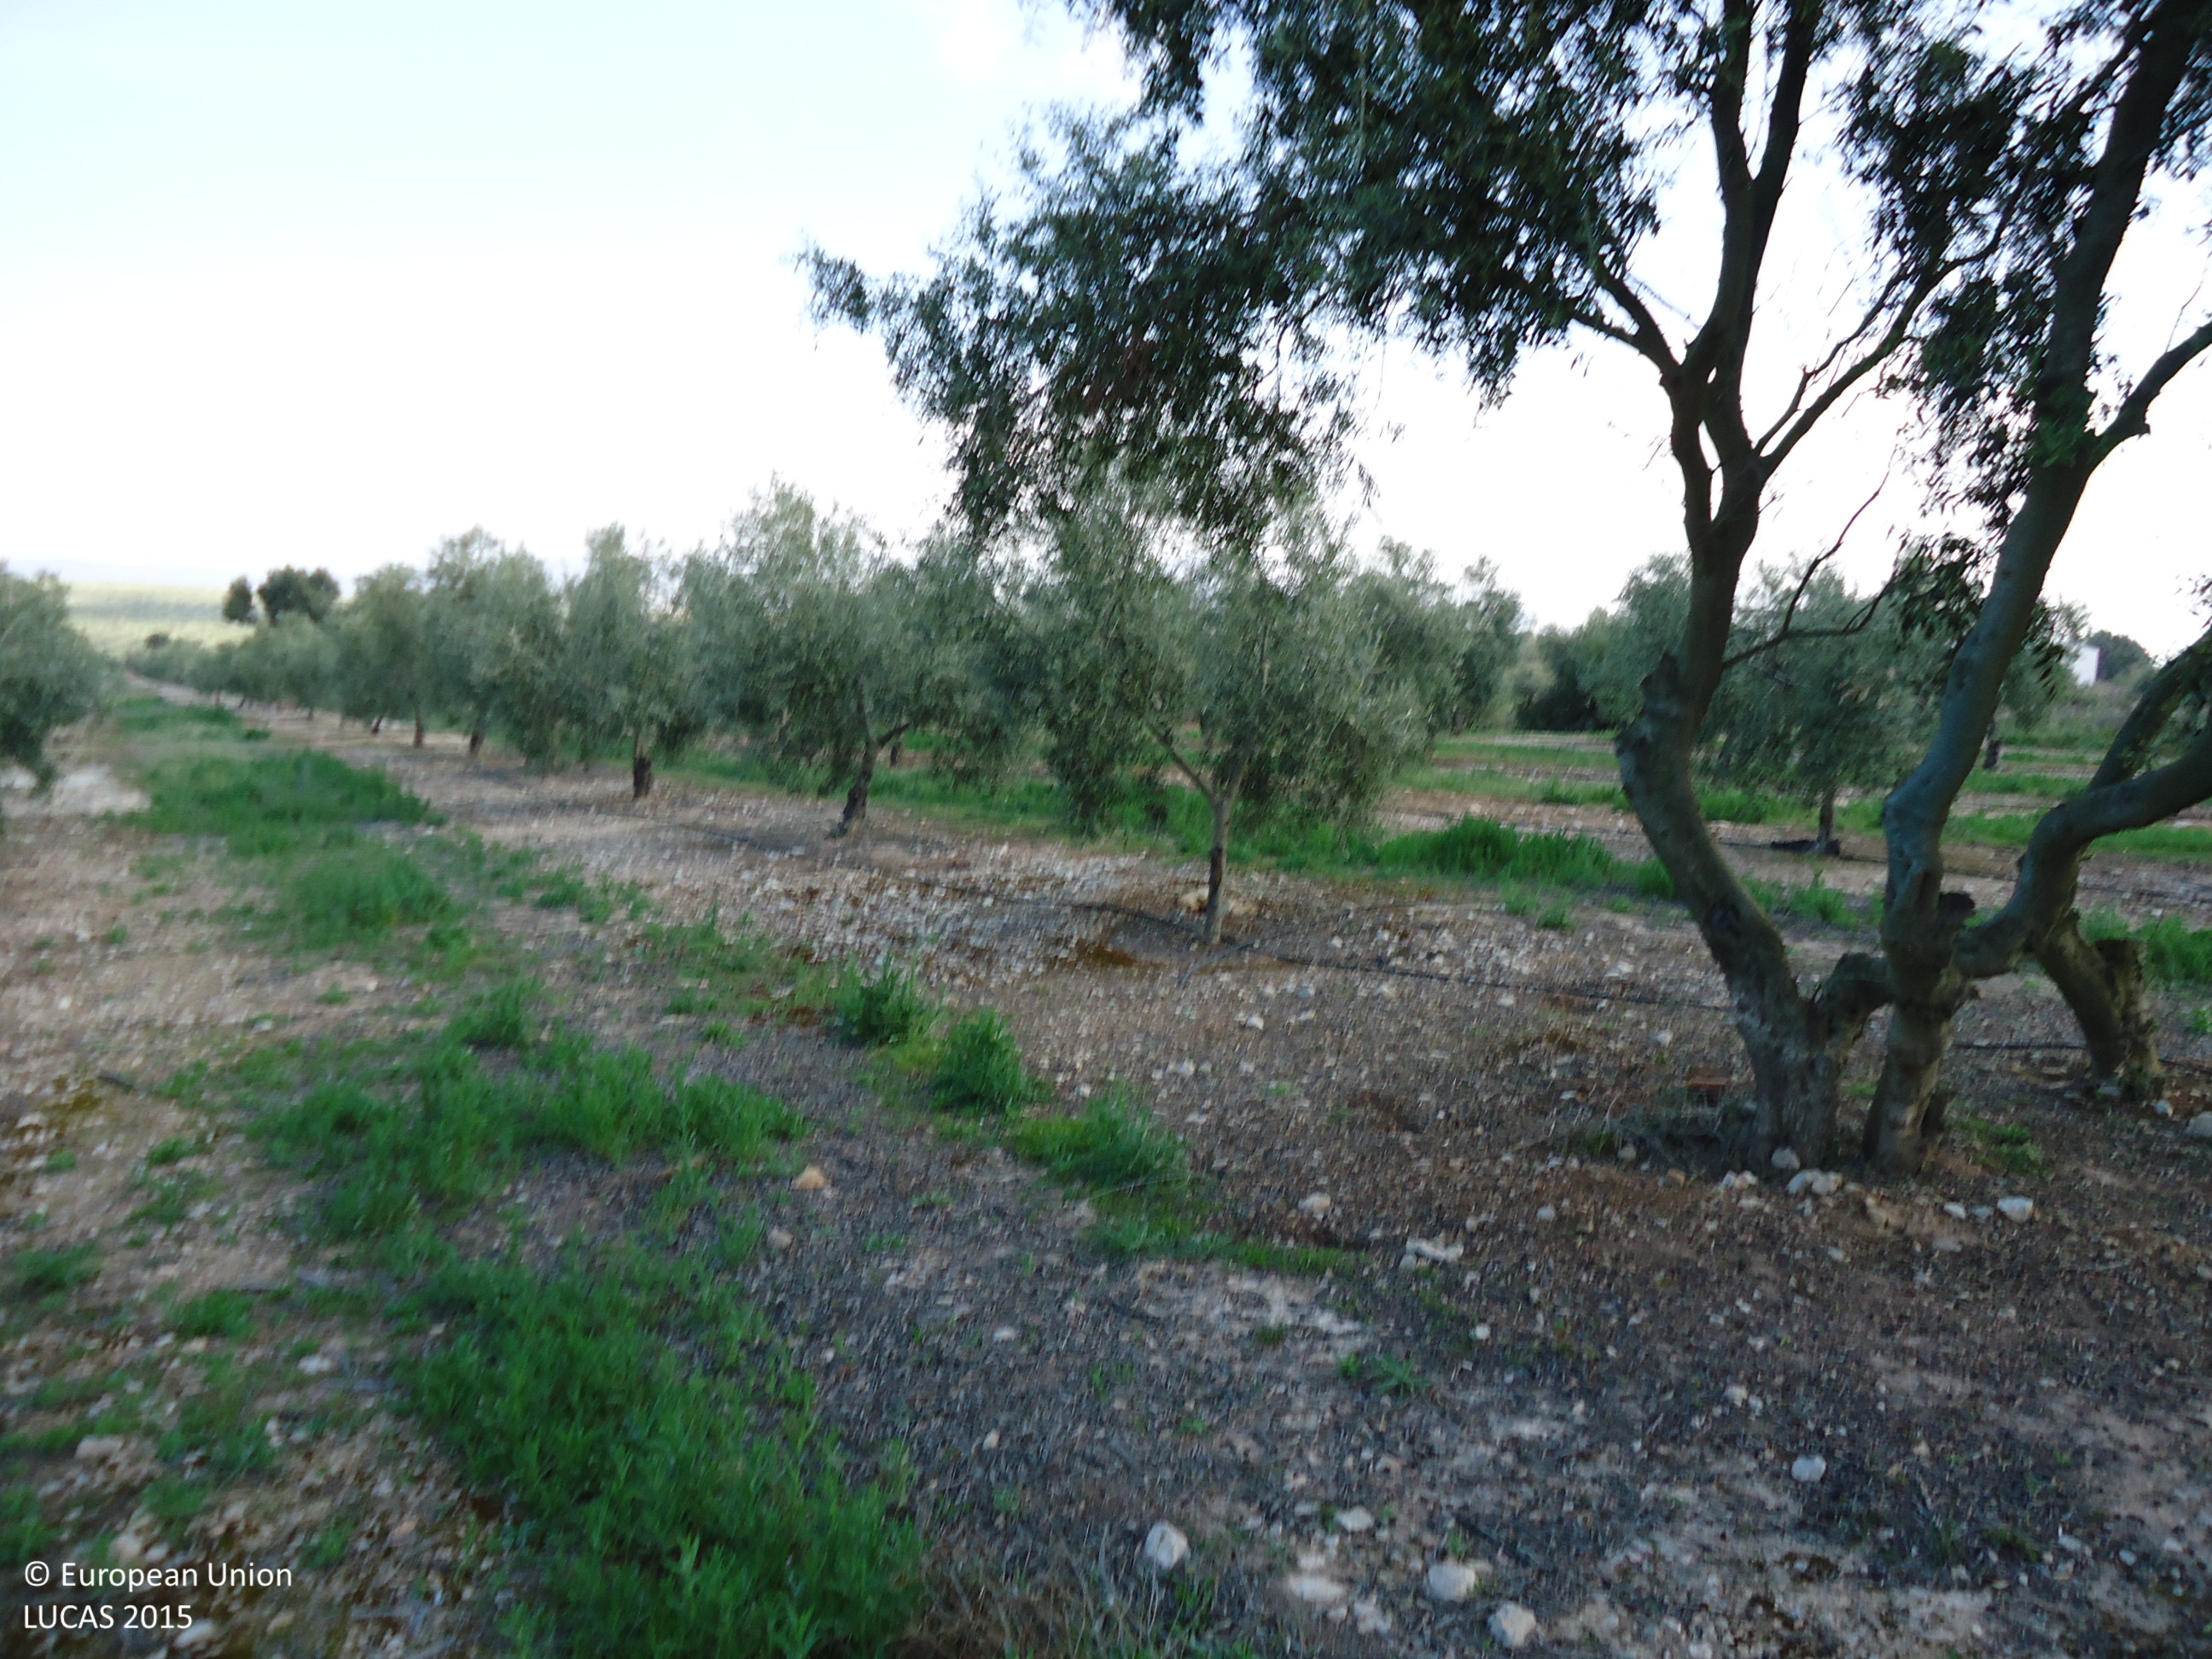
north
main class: Cropland
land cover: Olive groves
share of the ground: 25 - 50 %
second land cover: Spontaneously vegetated surfaces
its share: 50 - 75 %
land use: Agriculture (excluding fallow land and kitchen gardens)
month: April
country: ES
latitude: 37.1802
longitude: -4.8600
